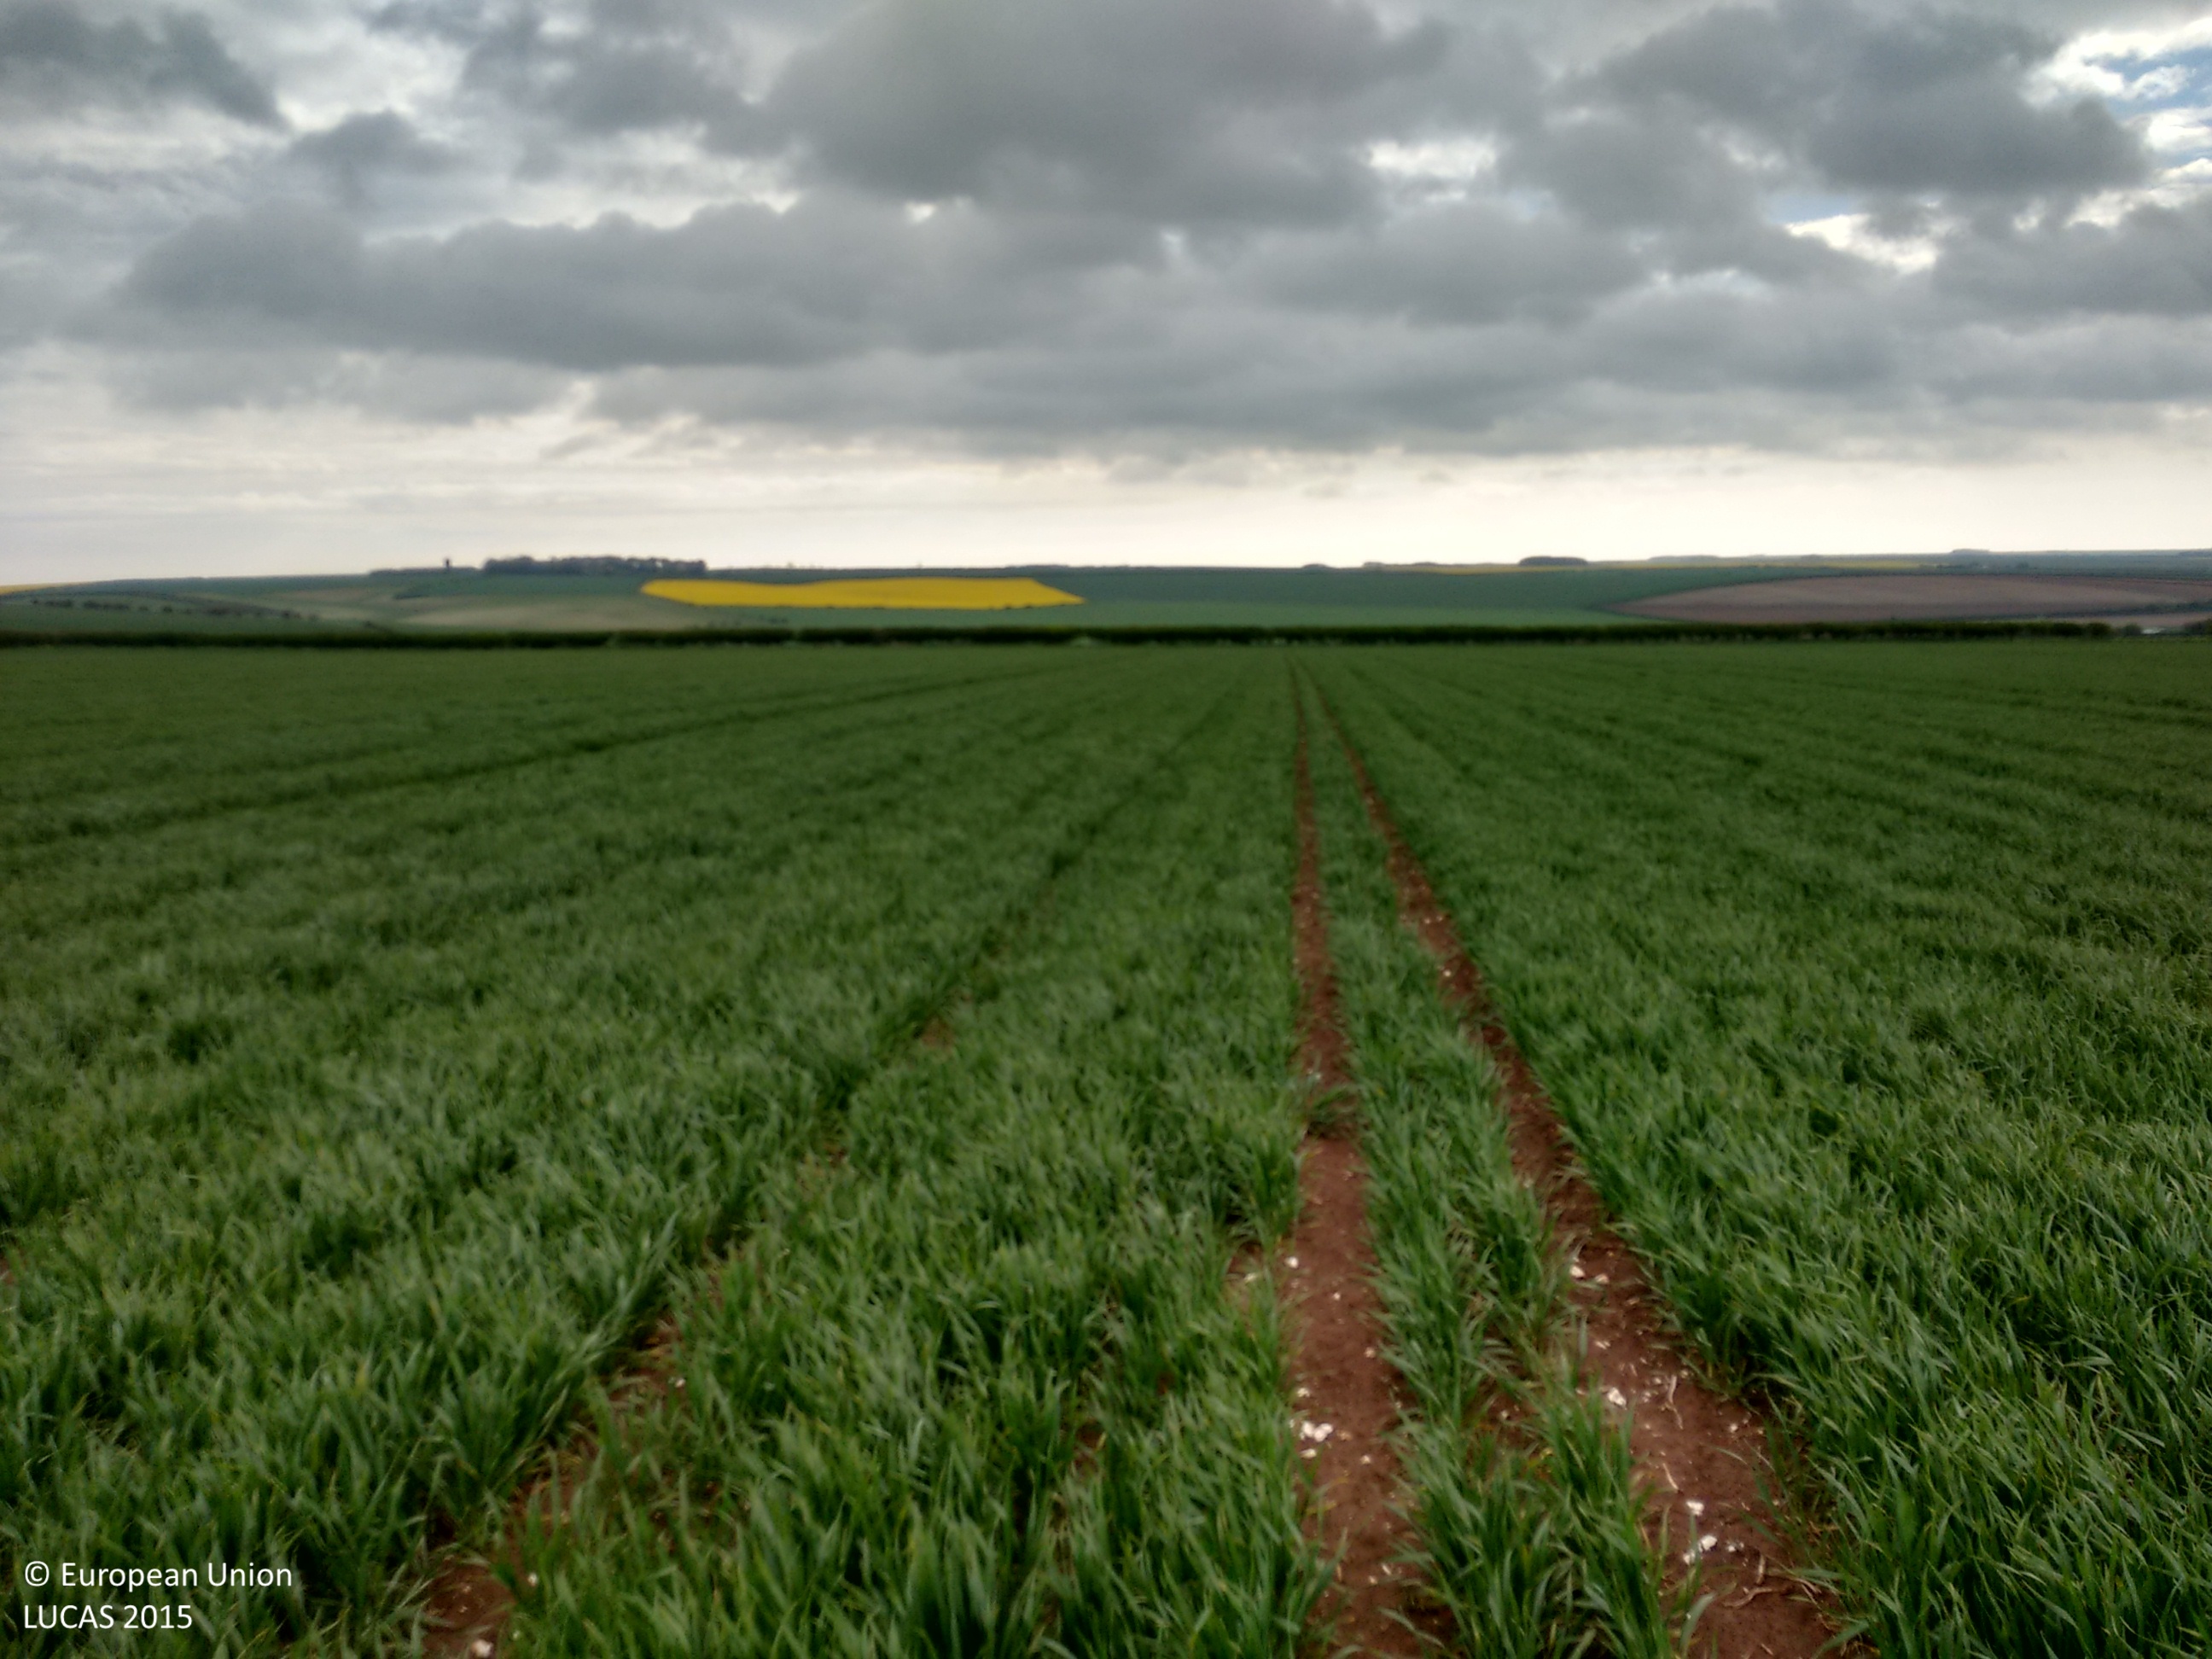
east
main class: Cropland
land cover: Common wheat
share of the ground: > 75 %
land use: Agriculture (excluding fallow land and kitchen gardens)
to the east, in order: Common wheat; Grass margins; Managed hedges; Grass margins; Barley
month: May
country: GB
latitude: 54.1523
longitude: -0.3701
